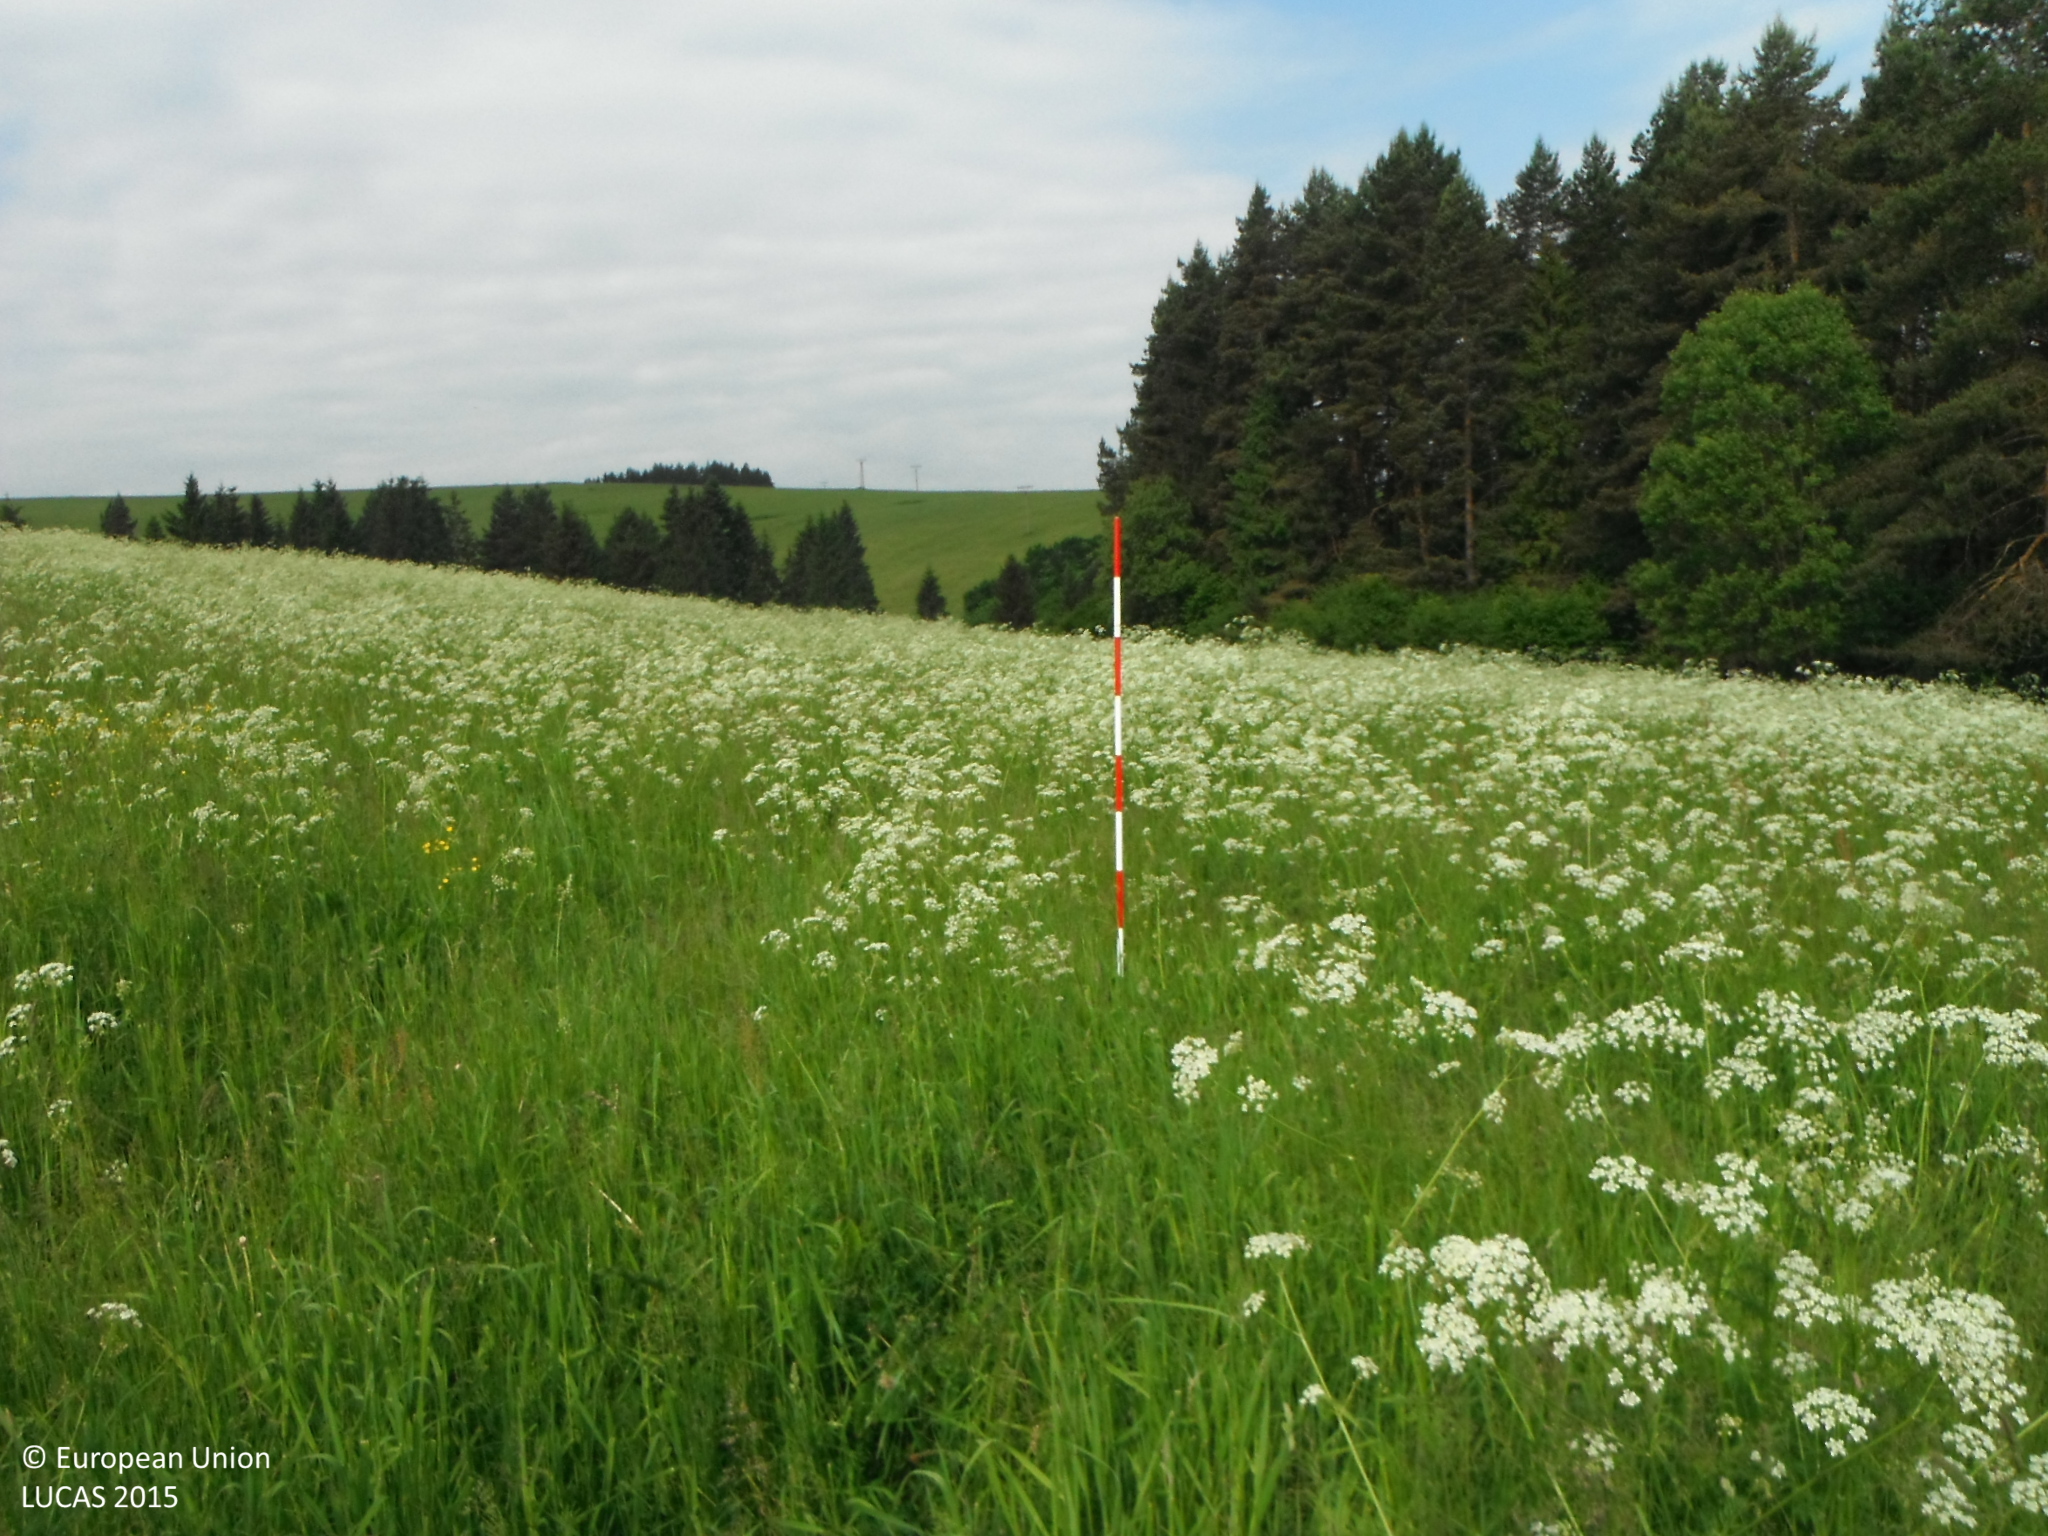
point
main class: Grassland
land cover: Grassland without tree/shrub cover
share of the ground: > 75 %
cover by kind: herbaceous plants 100 %
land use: Agriculture (excluding fallow land and kitchen gardens)
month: June
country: SK
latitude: 49.3827
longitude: 20.3804
